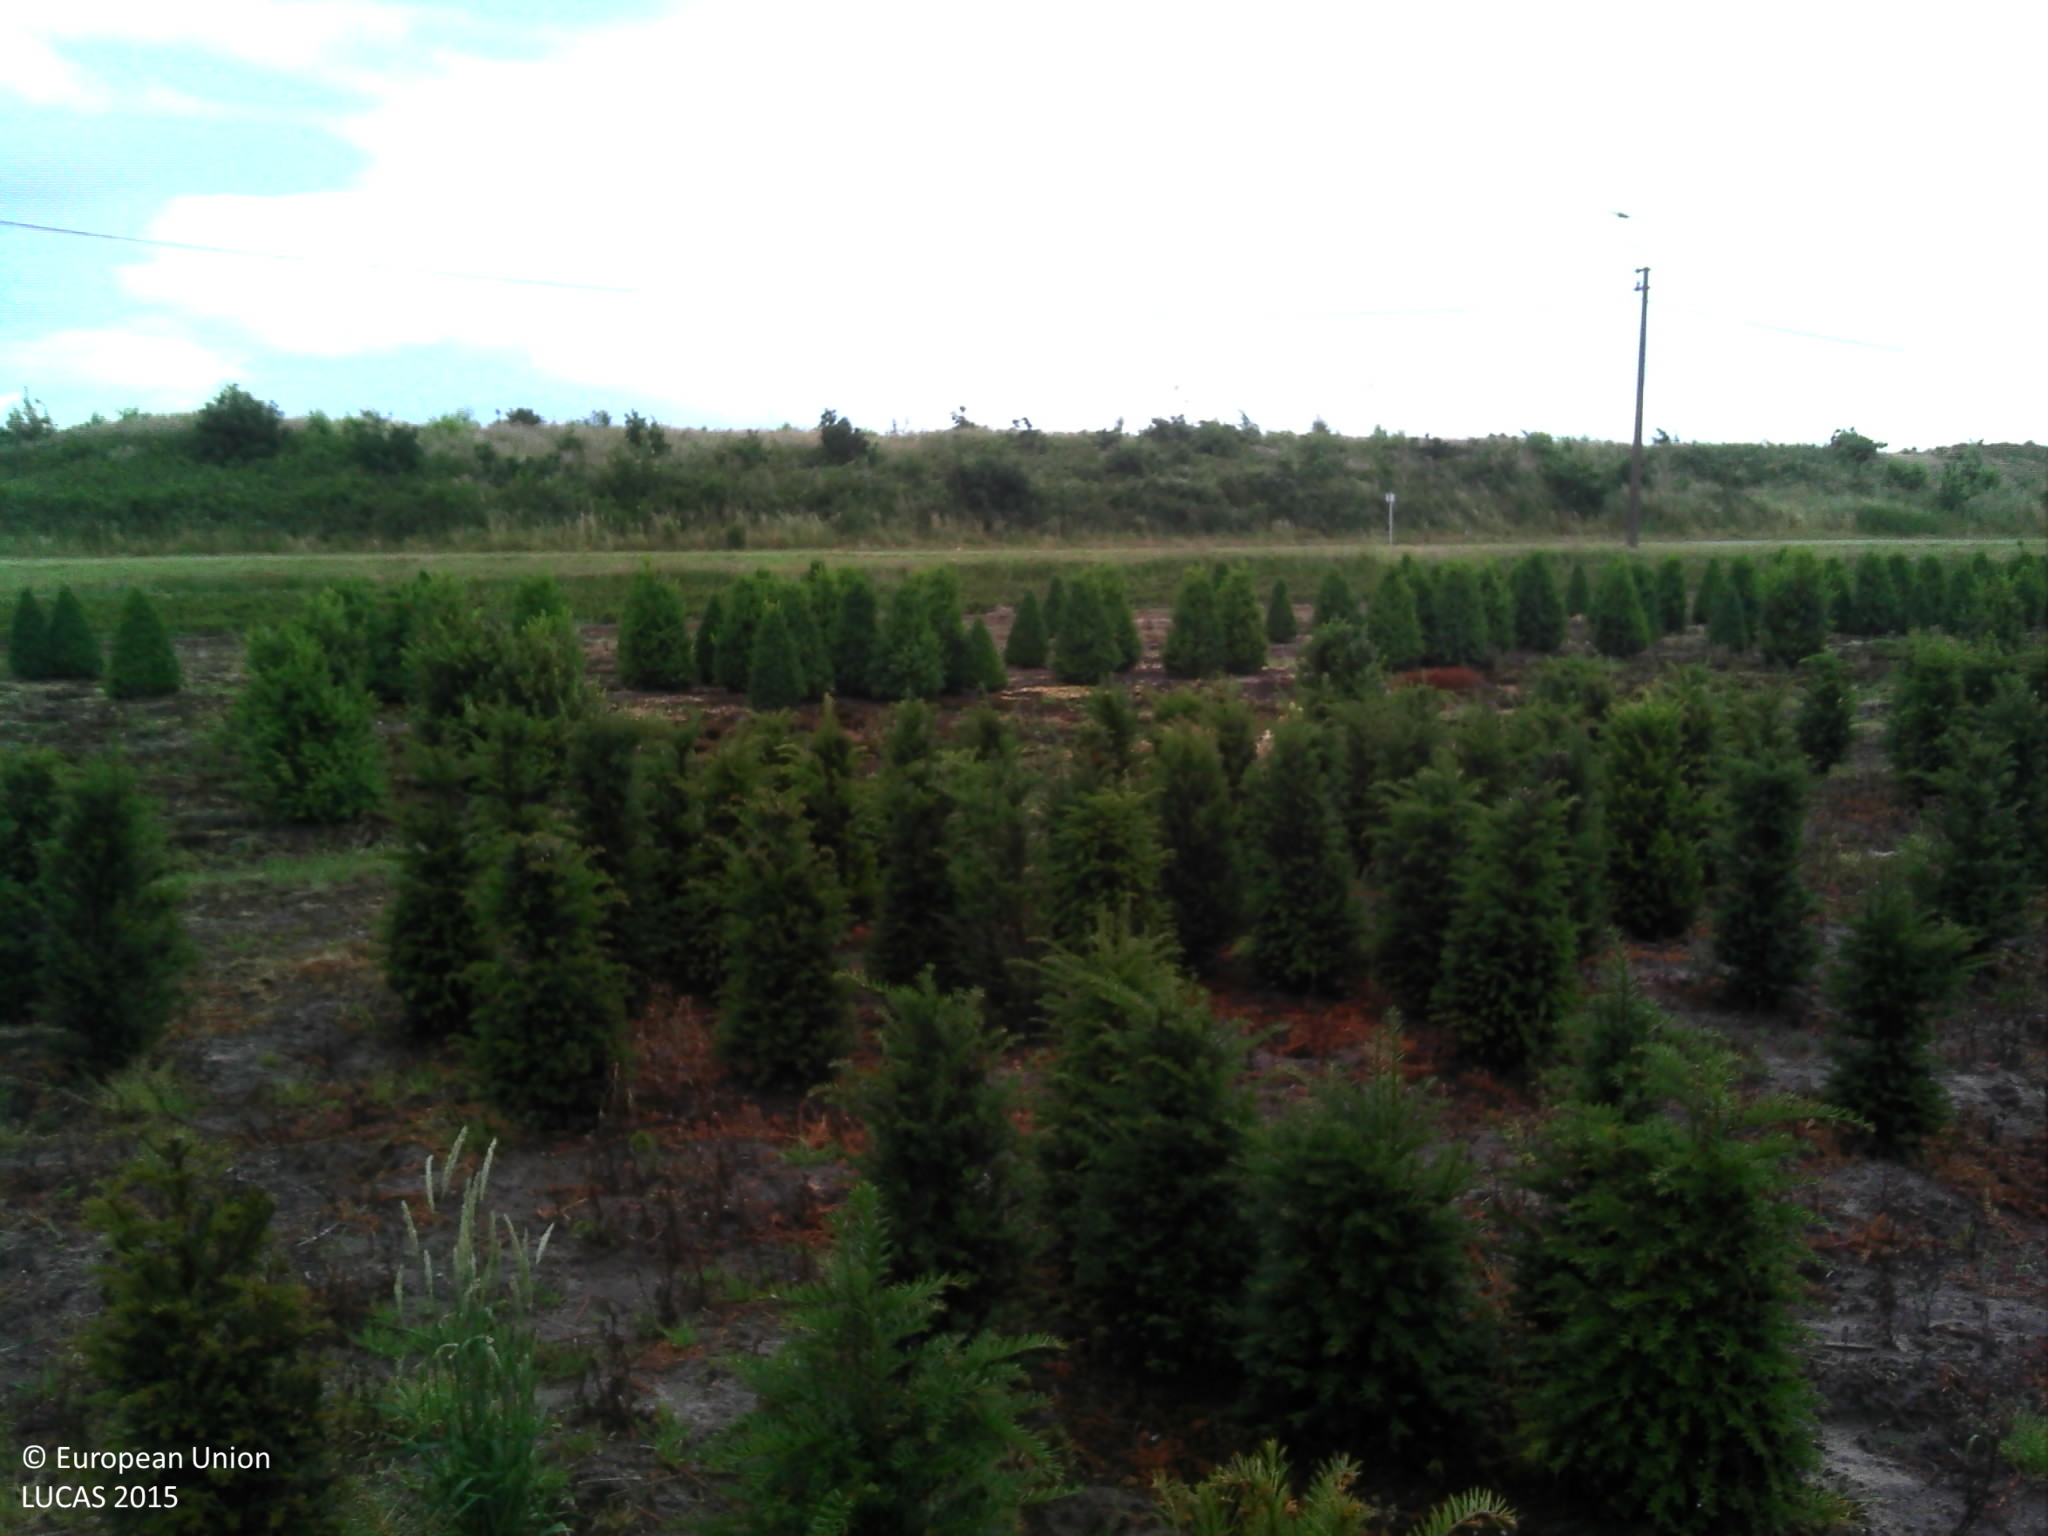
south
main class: Cropland
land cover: Nurseries
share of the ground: > 75 %
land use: Agriculture (excluding fallow land and kitchen gardens)
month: June
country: BE
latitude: 51.2101
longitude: 3.8814
